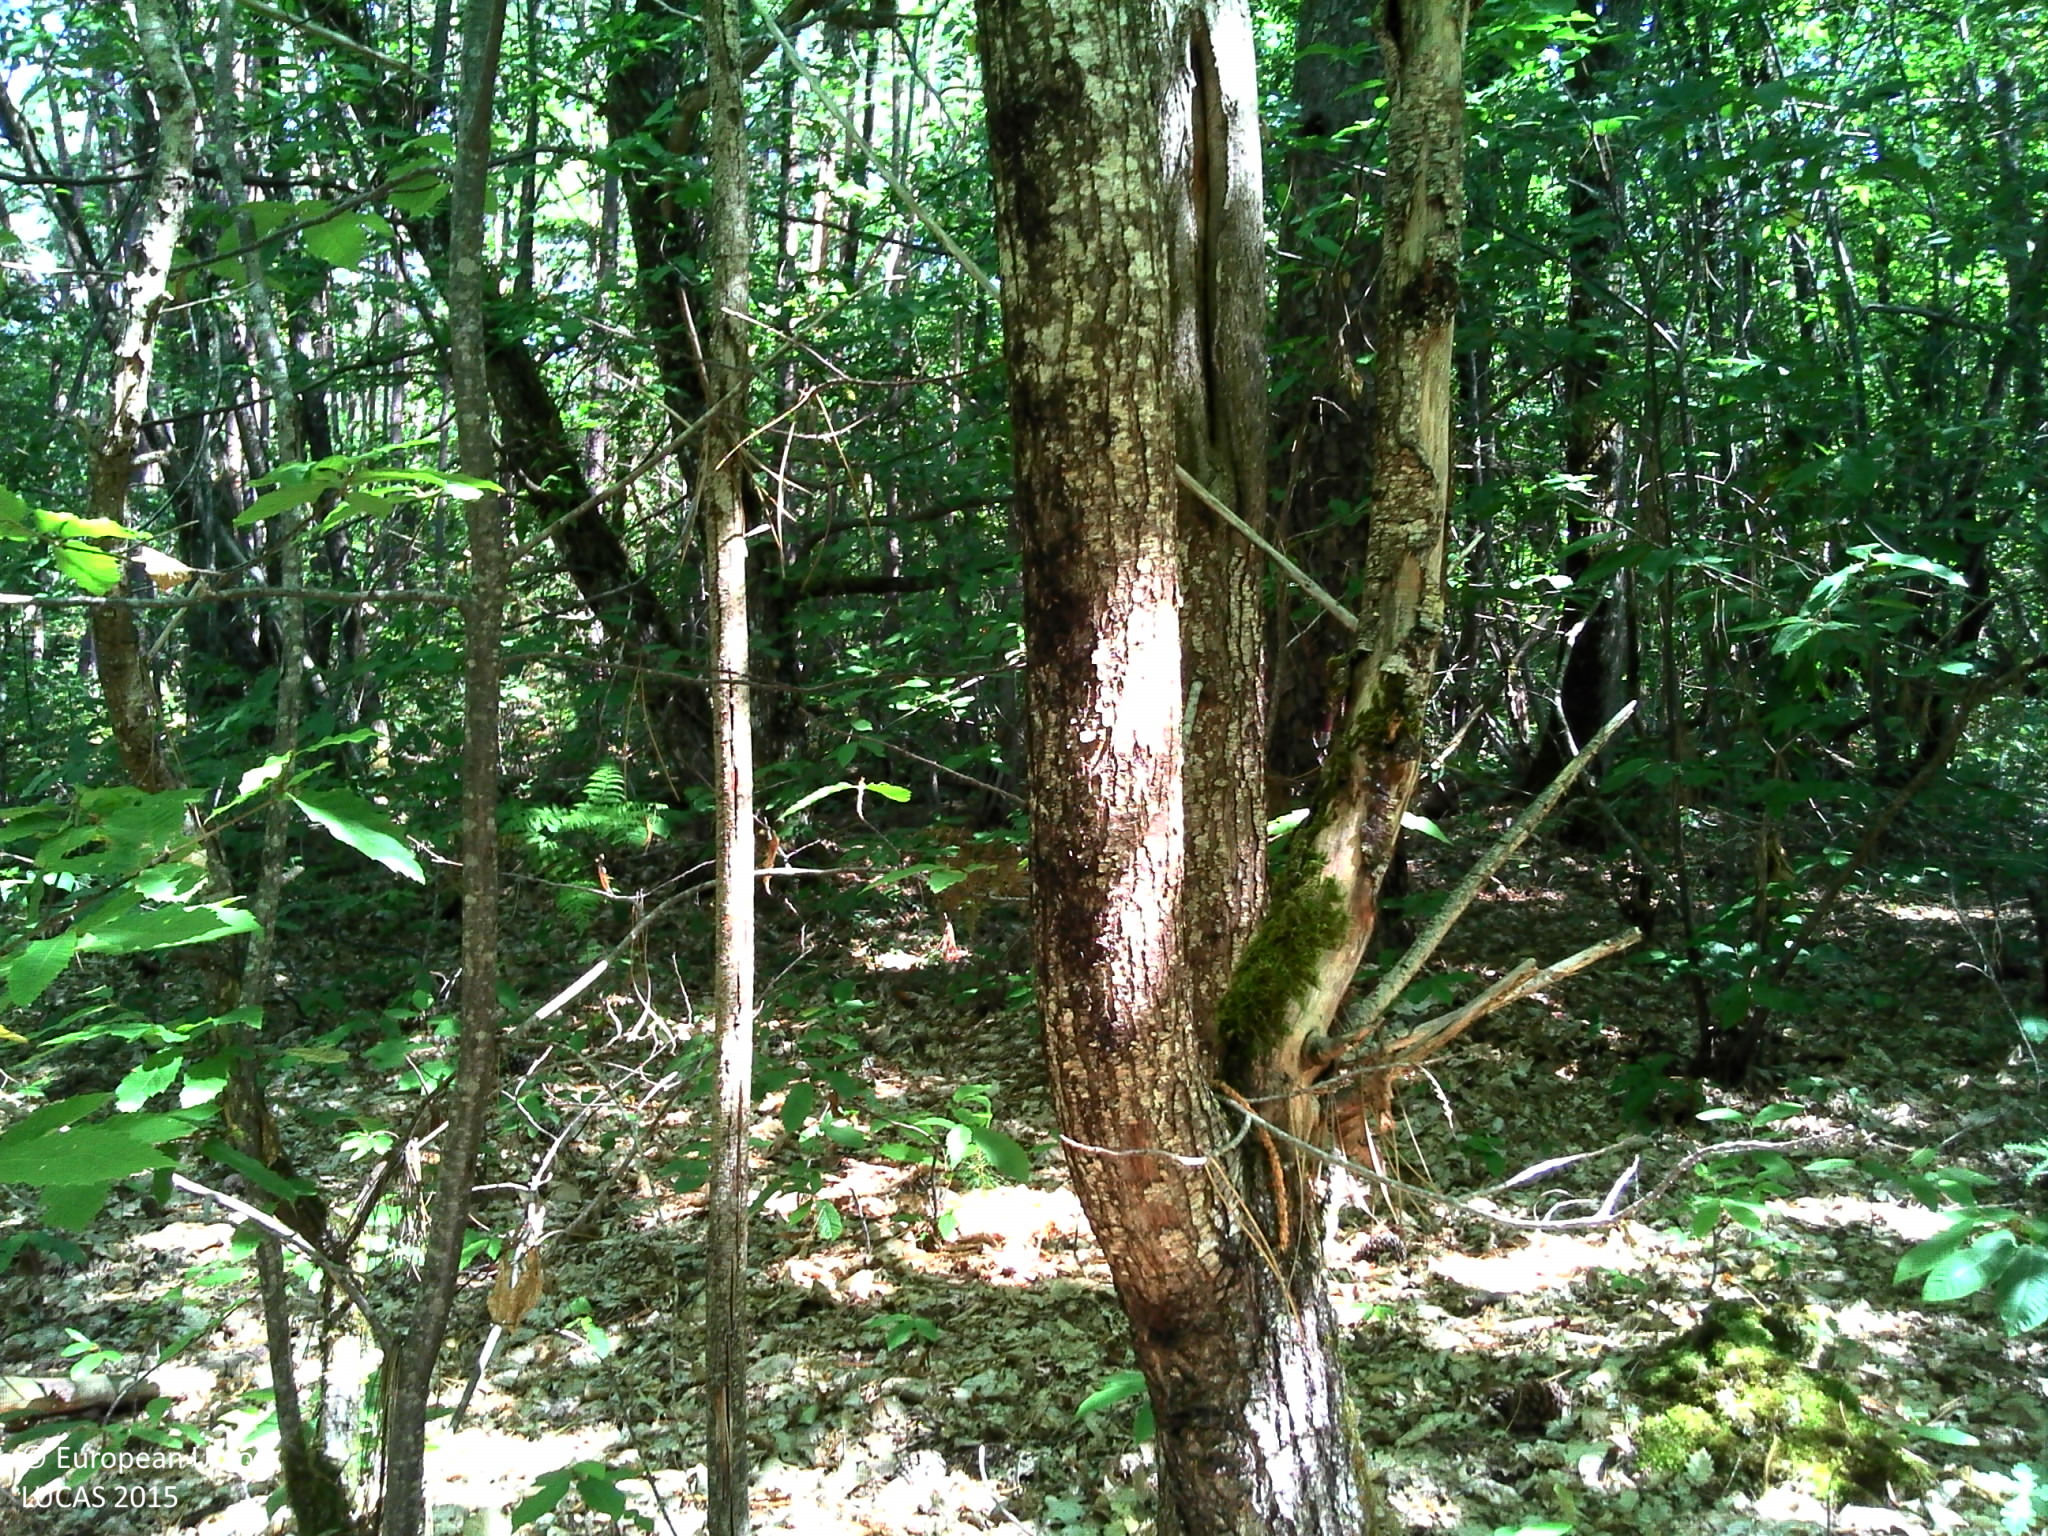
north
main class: Woodland
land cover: Broadleaved woodland
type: acidophilous oak and oak-birch forest
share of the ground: > 75 %
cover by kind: broadleaved forest trees 80 %, herbaceous plants 10 %, shrubs 5 %, lichens and mosses 5 %
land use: Forestry
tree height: > 5 m
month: July
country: FR
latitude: 44.9167
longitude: 0.5530
